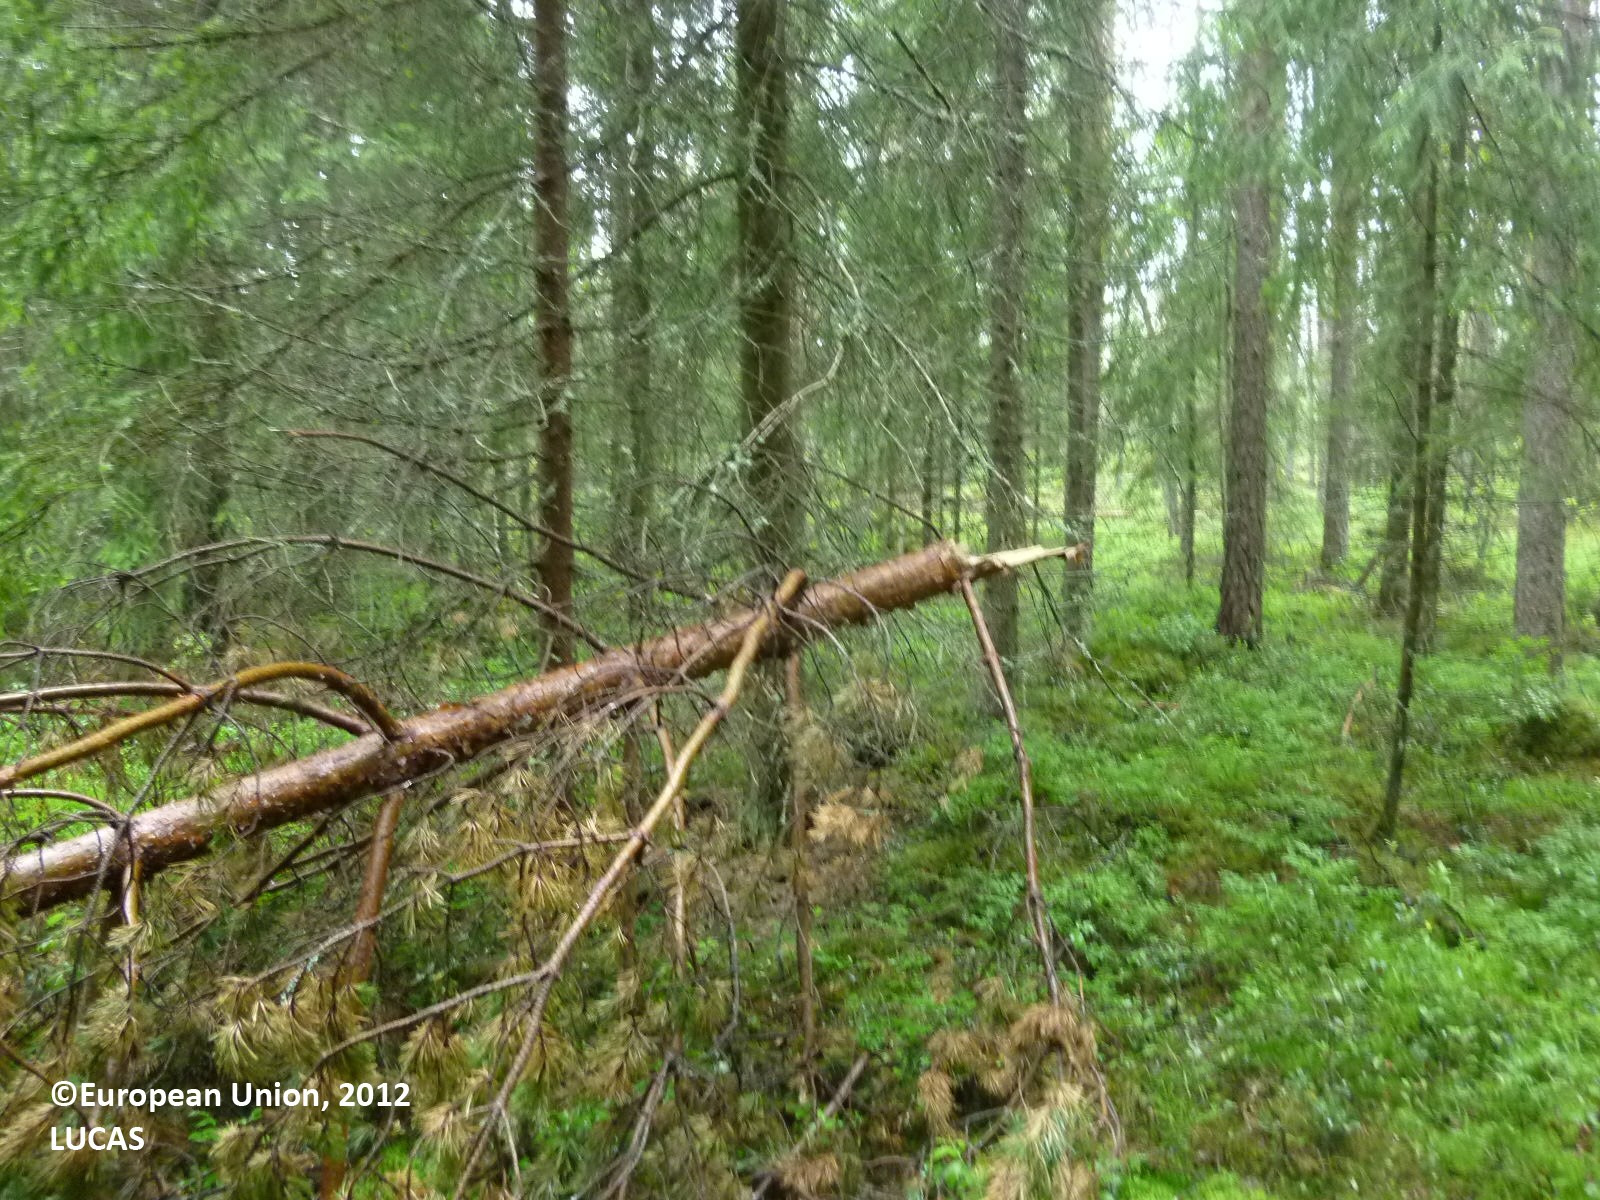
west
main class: Woodland
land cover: Spruce dominated coniferous woodland
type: boreal forest
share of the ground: > 75 %
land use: Forestry
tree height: > 5 m
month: July
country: FI
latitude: 61.4502
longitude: 22.2712
